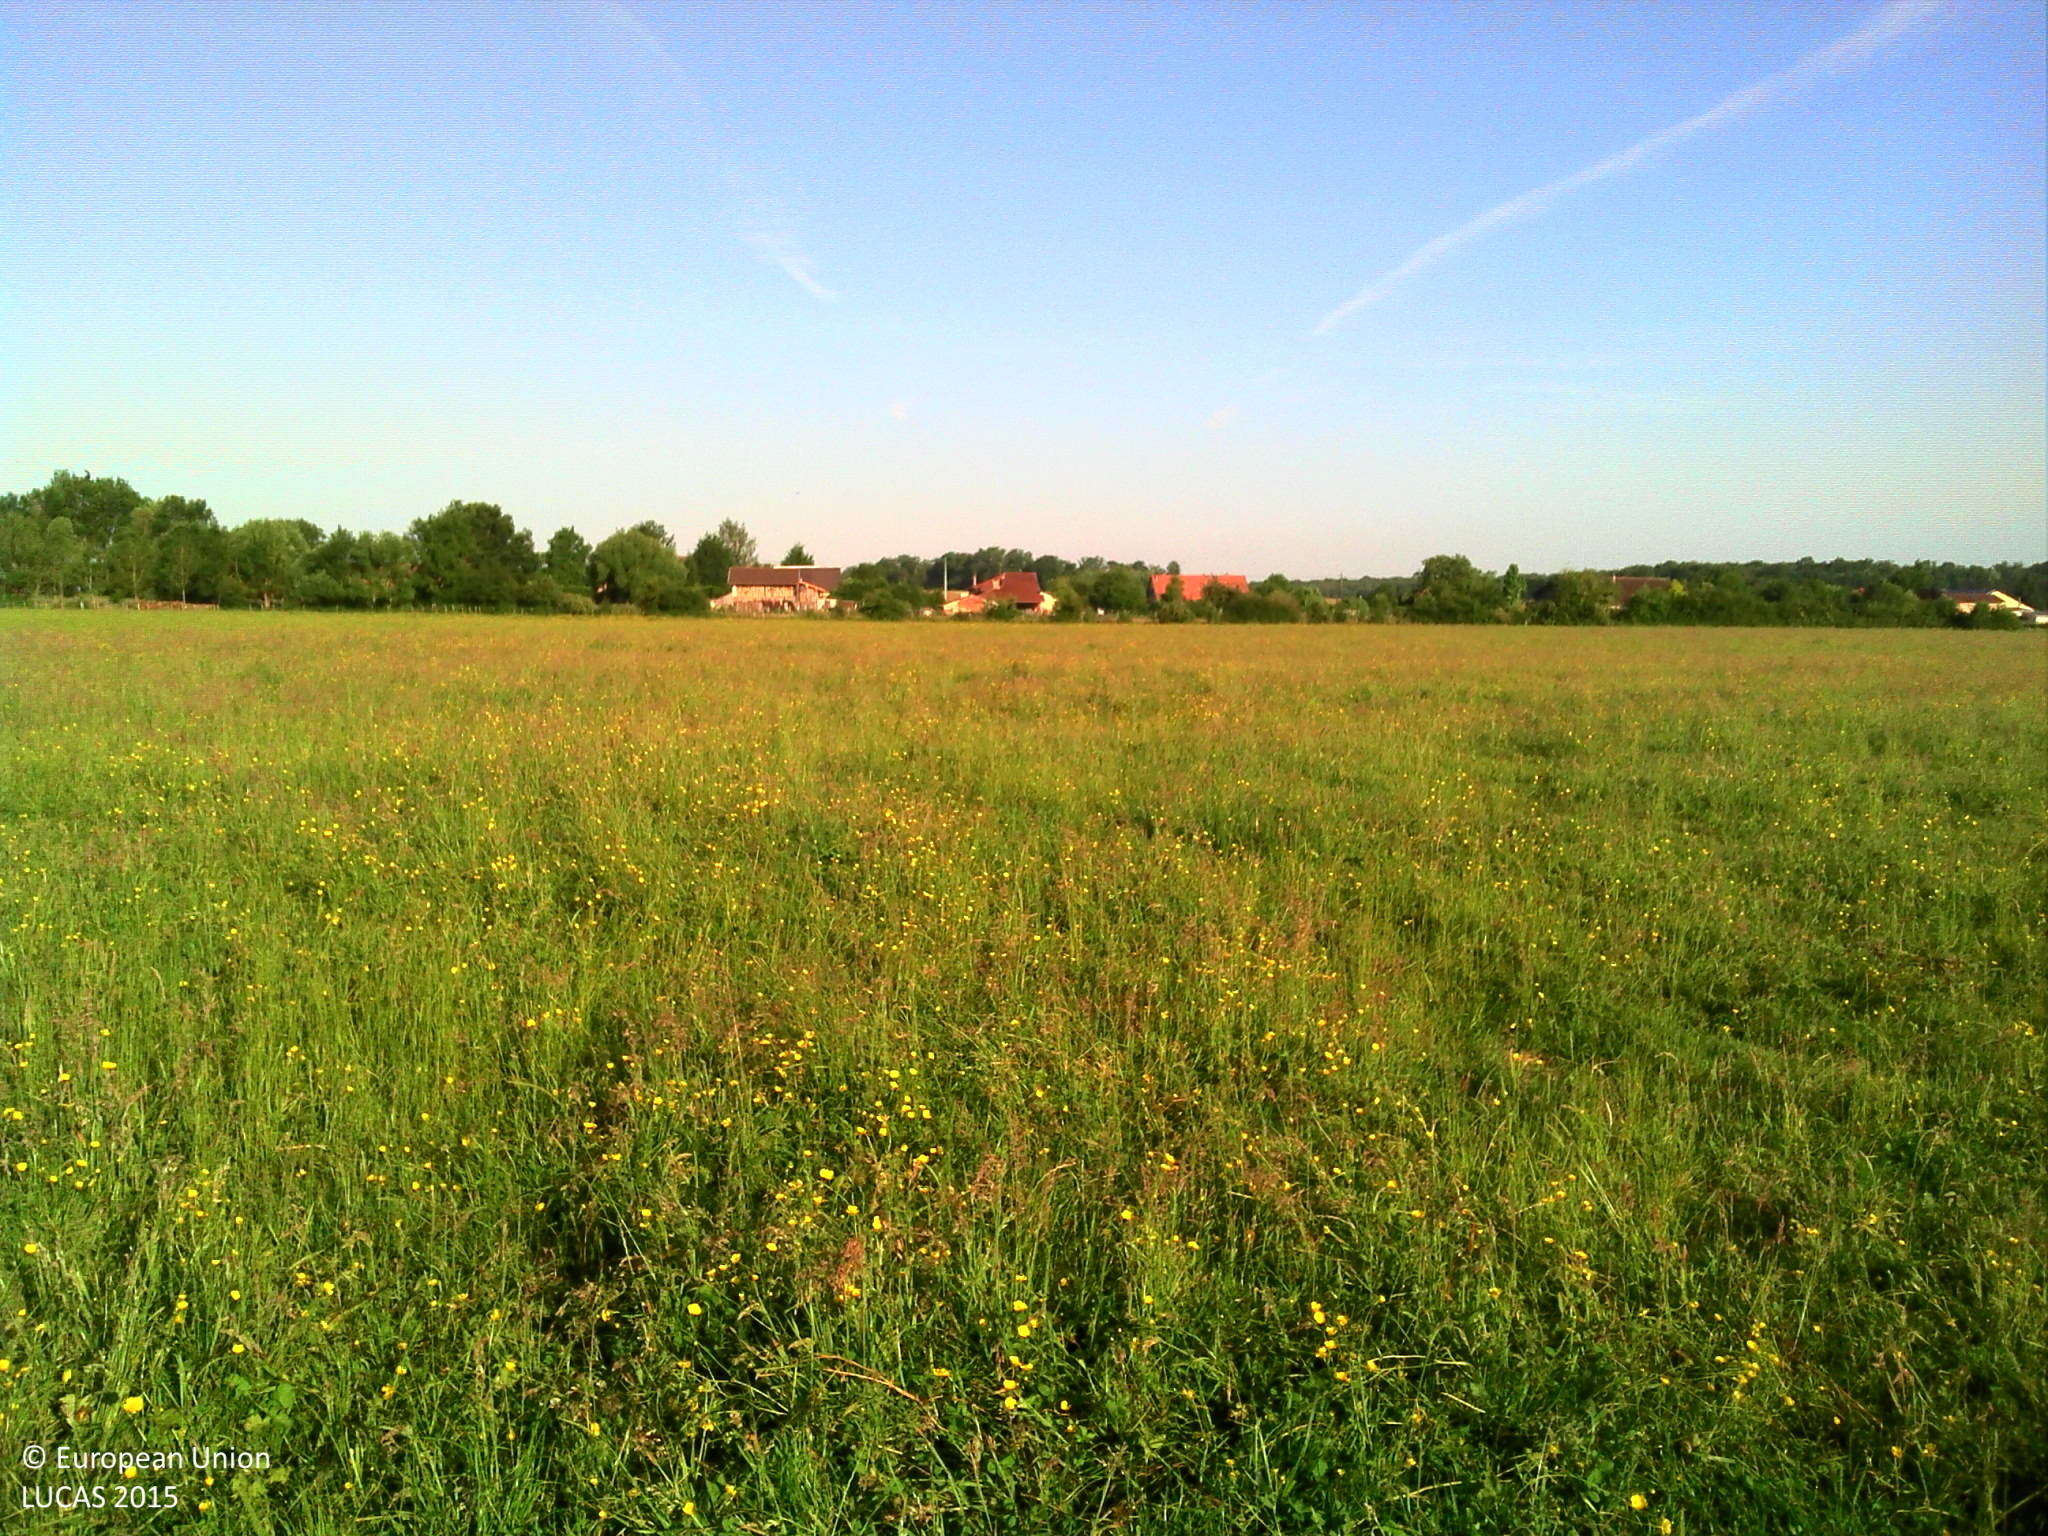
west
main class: Grassland
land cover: Grassland without tree/shrub cover
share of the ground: > 75 %
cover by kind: herbaceous plants 100 %
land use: Agriculture (excluding fallow land and kitchen gardens)
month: June
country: FR
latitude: 48.5149
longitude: 4.7859
